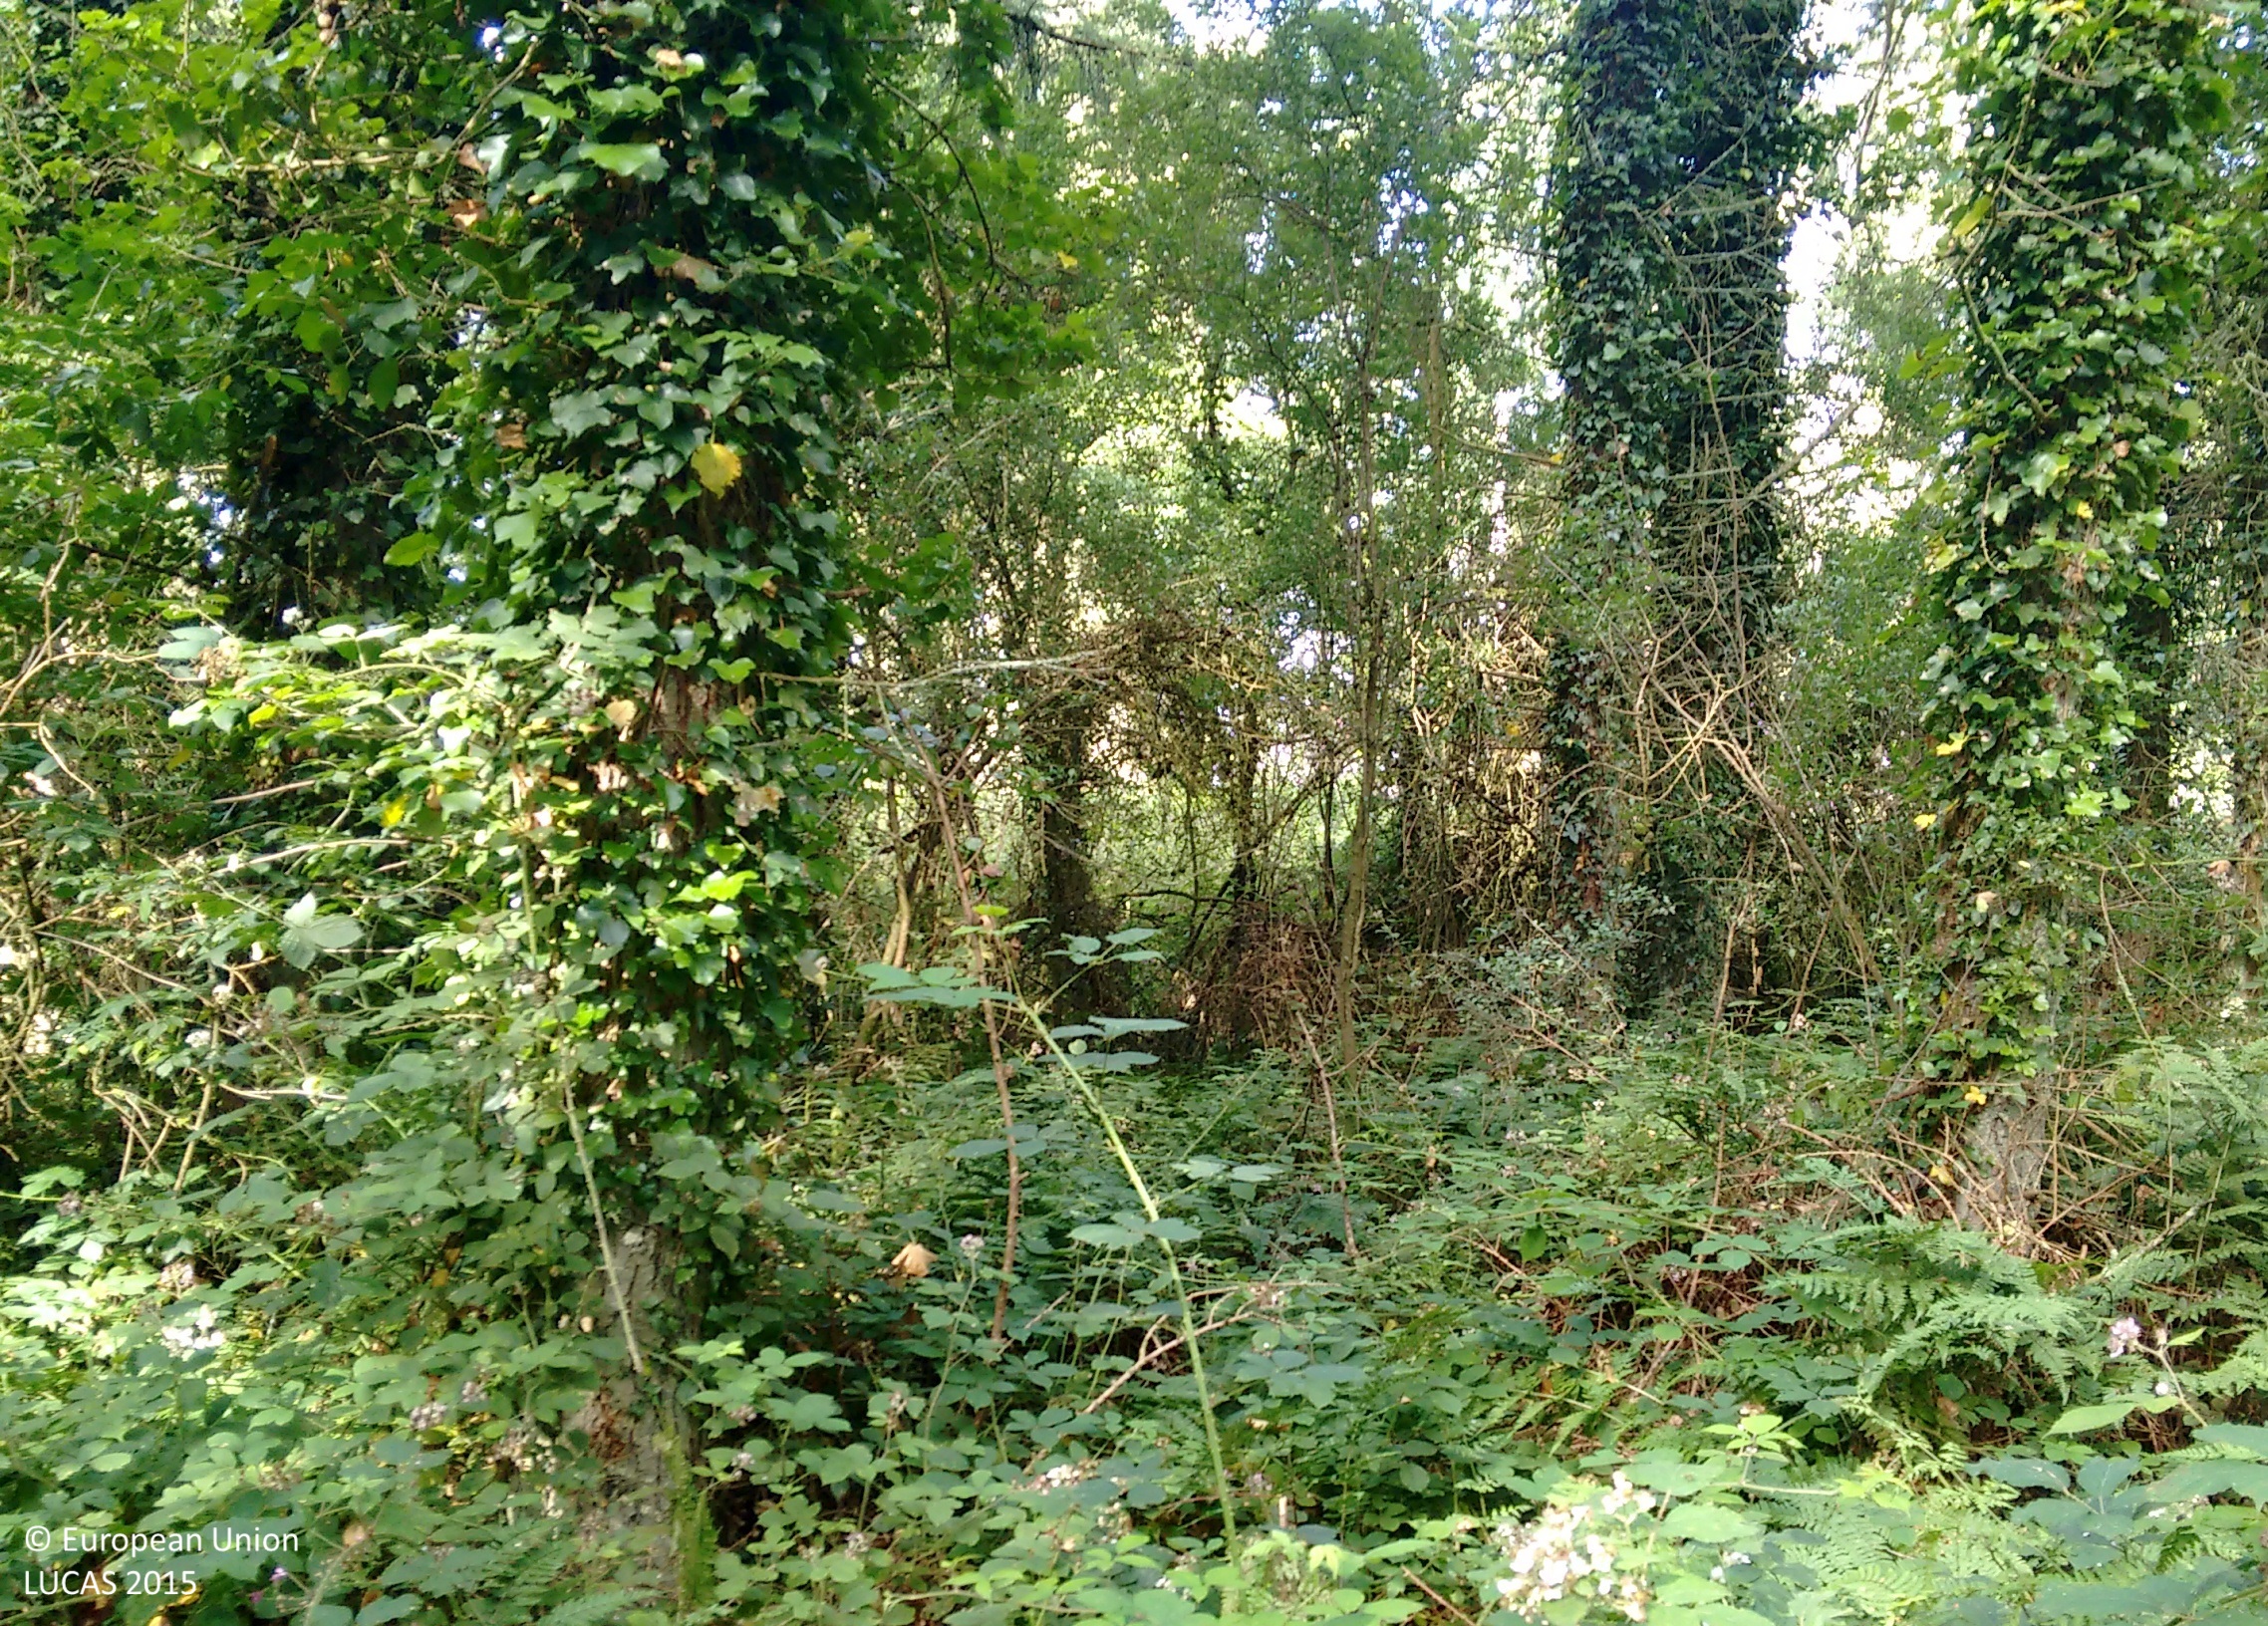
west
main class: Woodland
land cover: Pine dominated coniferous woodland
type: exotic forest
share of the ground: > 75 %
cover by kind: coniferous forest trees 100 %
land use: Forestry
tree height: > 5 m
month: August
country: GB
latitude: 53.2744
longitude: -4.3323
